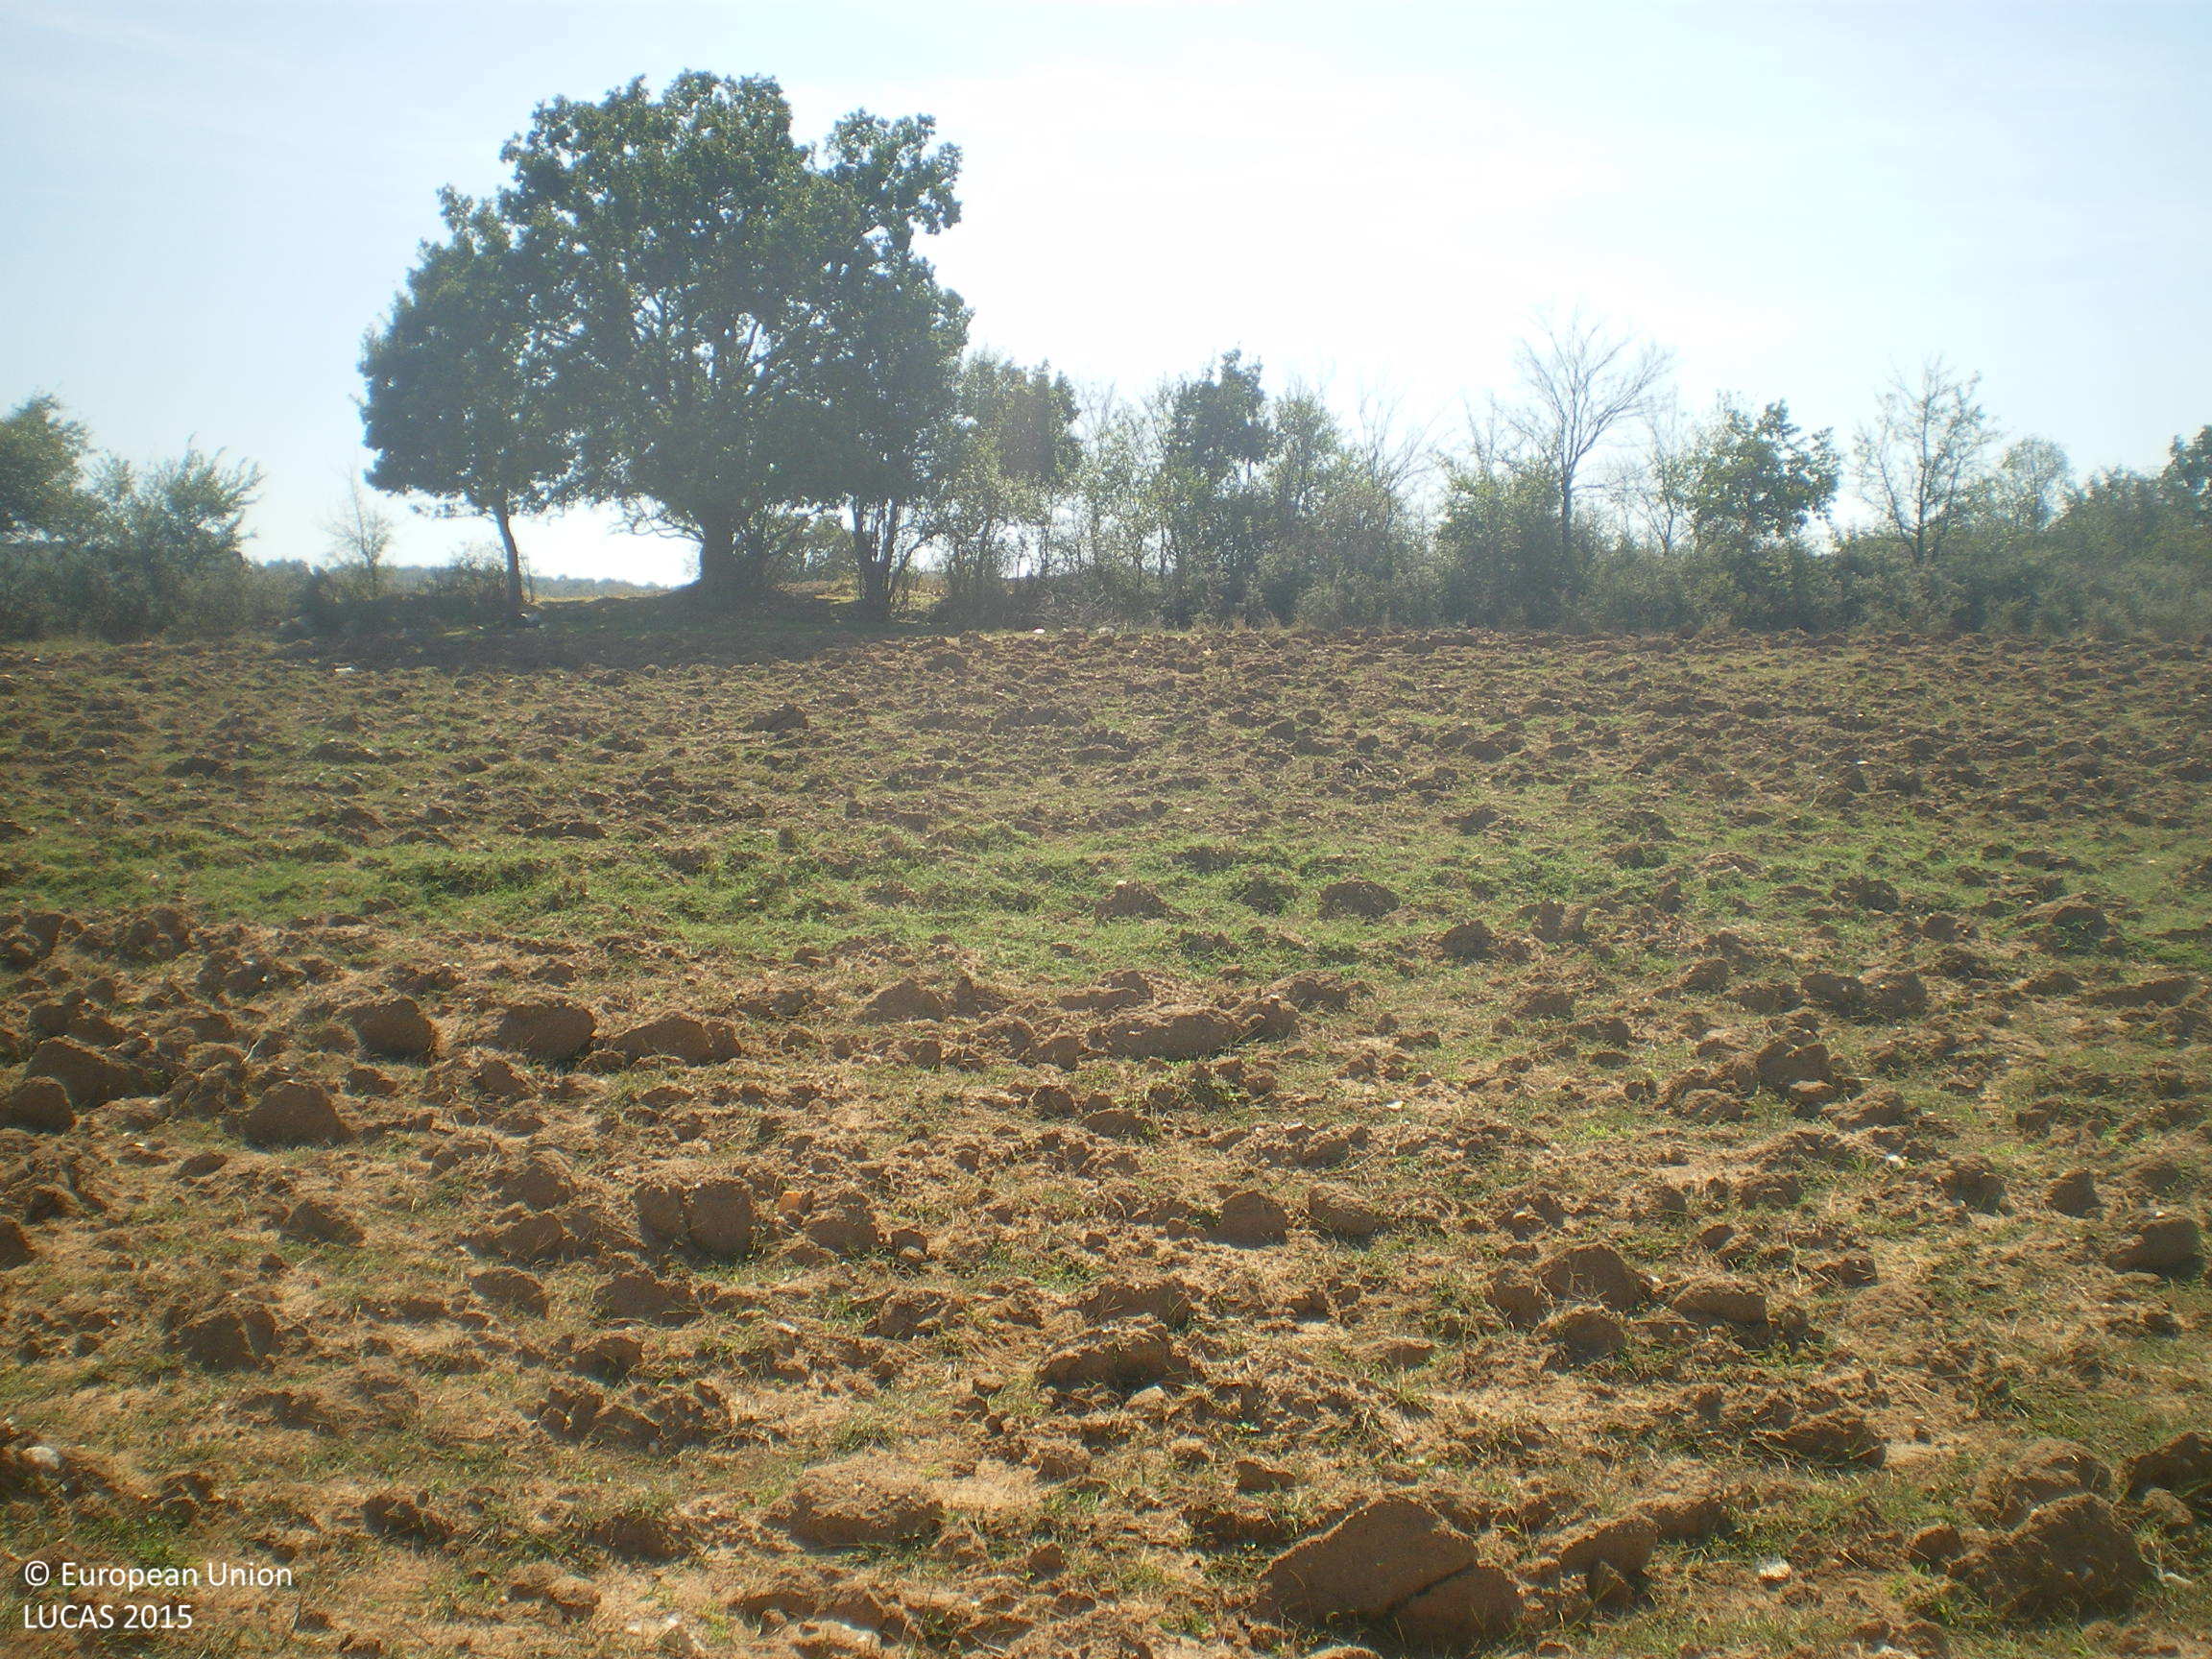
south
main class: Grassland
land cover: Spontaneously vegetated surfaces
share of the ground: 25 - 50 %
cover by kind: herbaceous plants 80 %, consolidated bare surface 20 %
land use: Agriculture (excluding fallow land and kitchen gardens)
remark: Harvested field
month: September
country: BG
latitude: 41.8944
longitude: 25.7239
